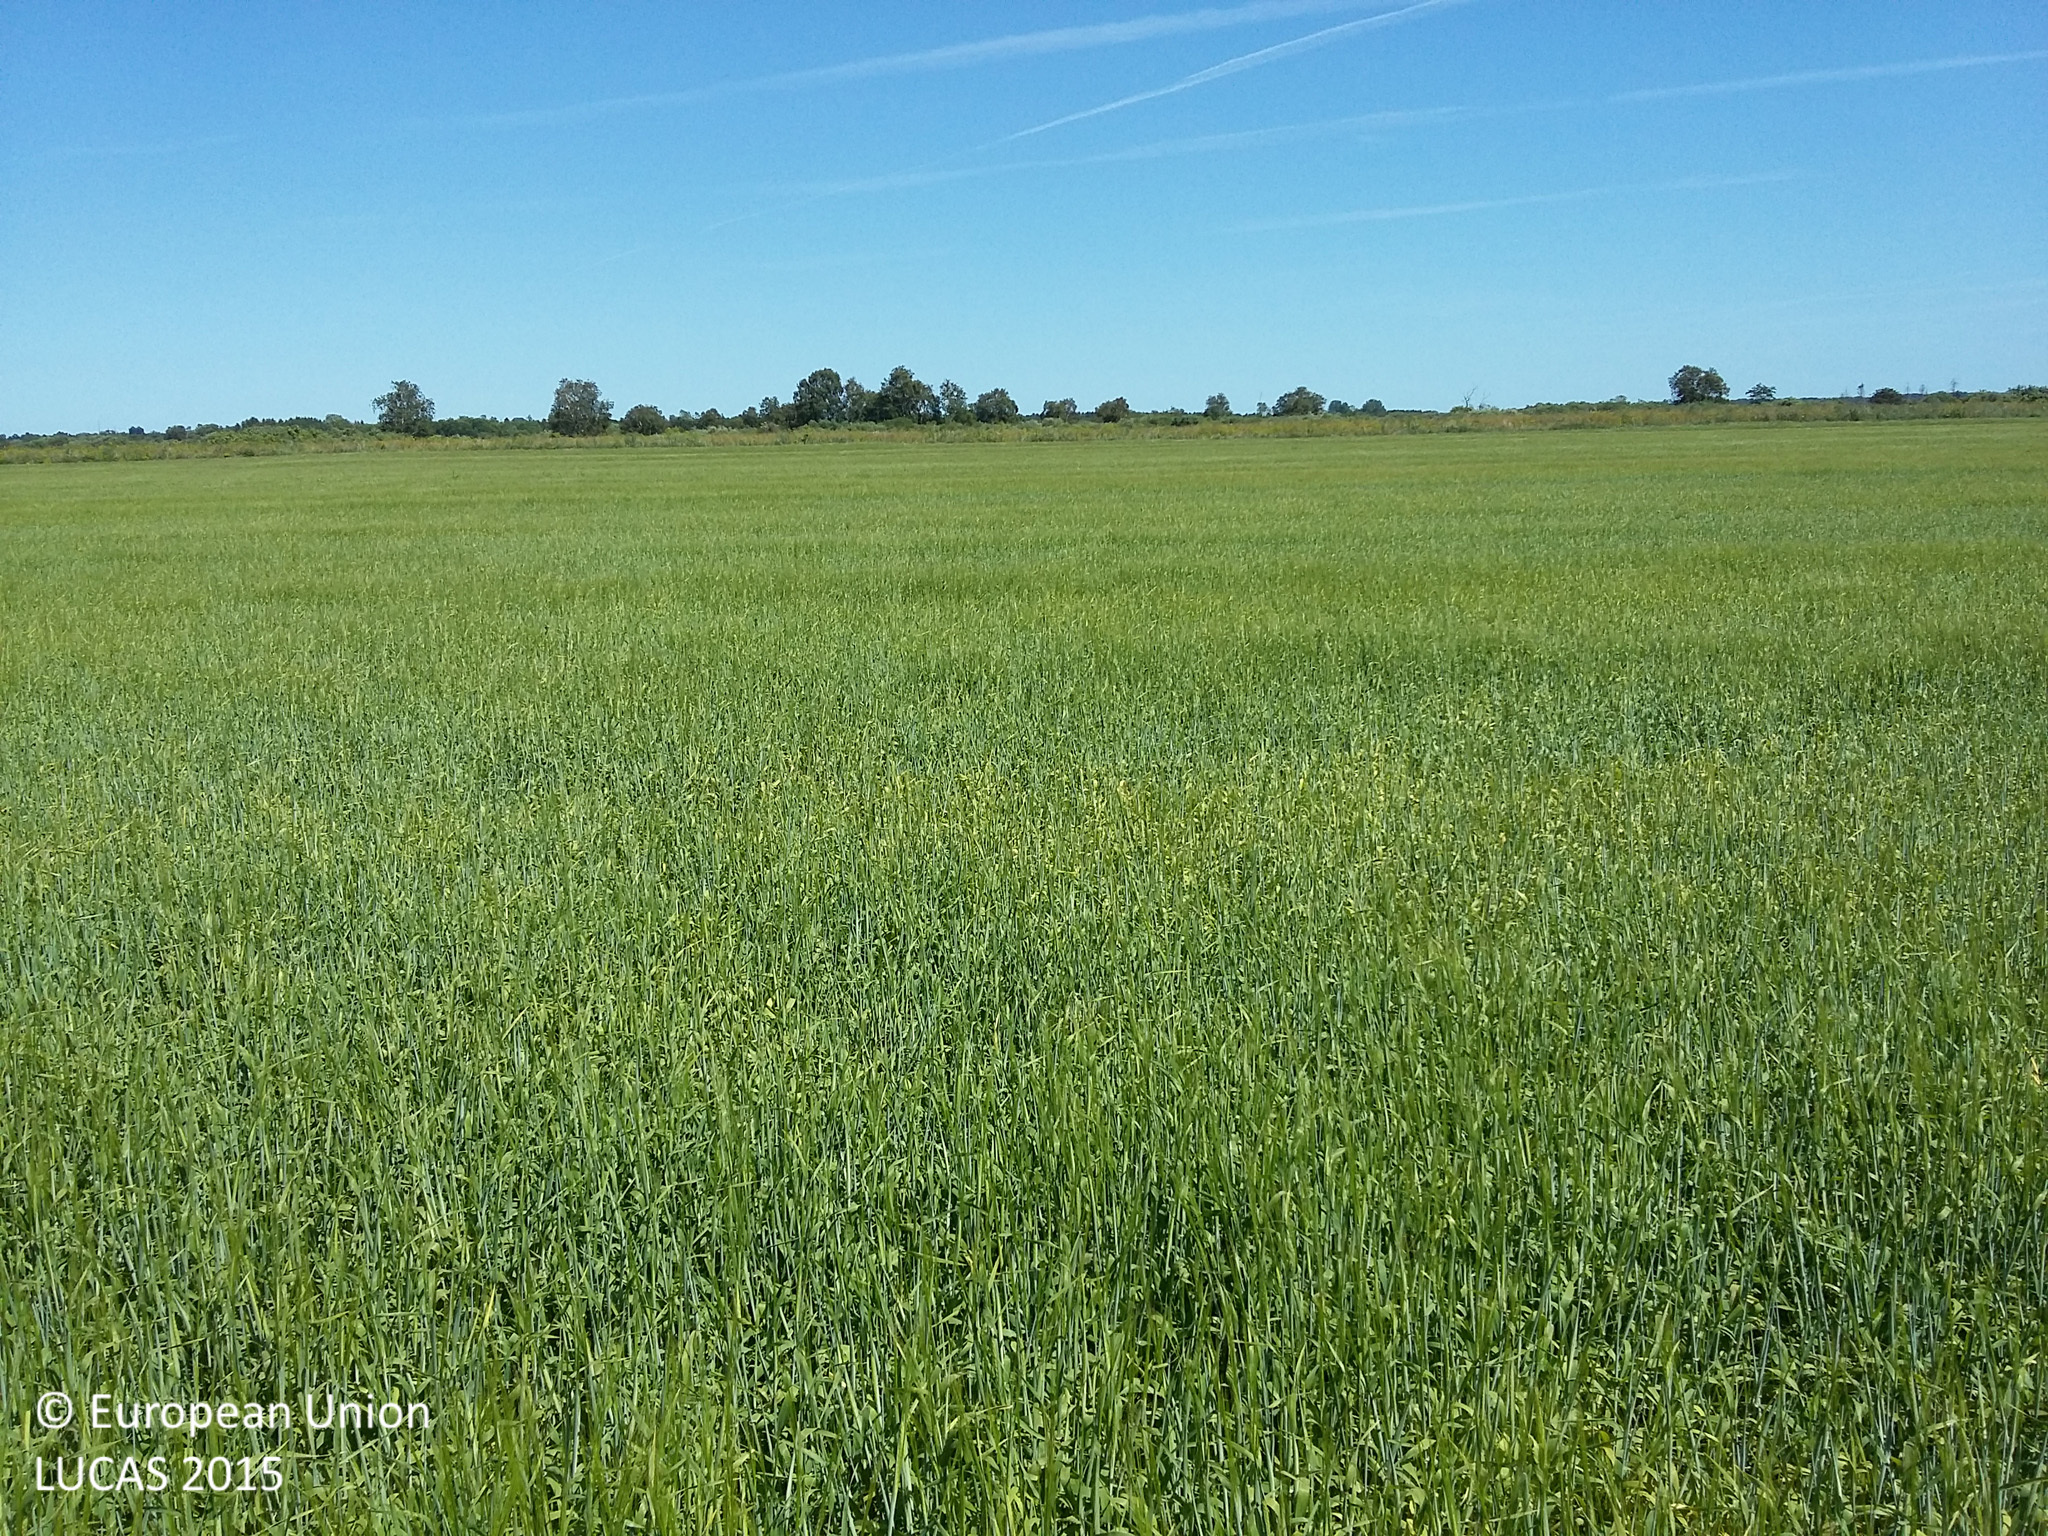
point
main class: Cropland
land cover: Barley
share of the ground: > 75 %
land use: Agriculture (excluding fallow land and kitchen gardens)
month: July
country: DK
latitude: 55.5853
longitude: 11.5375
